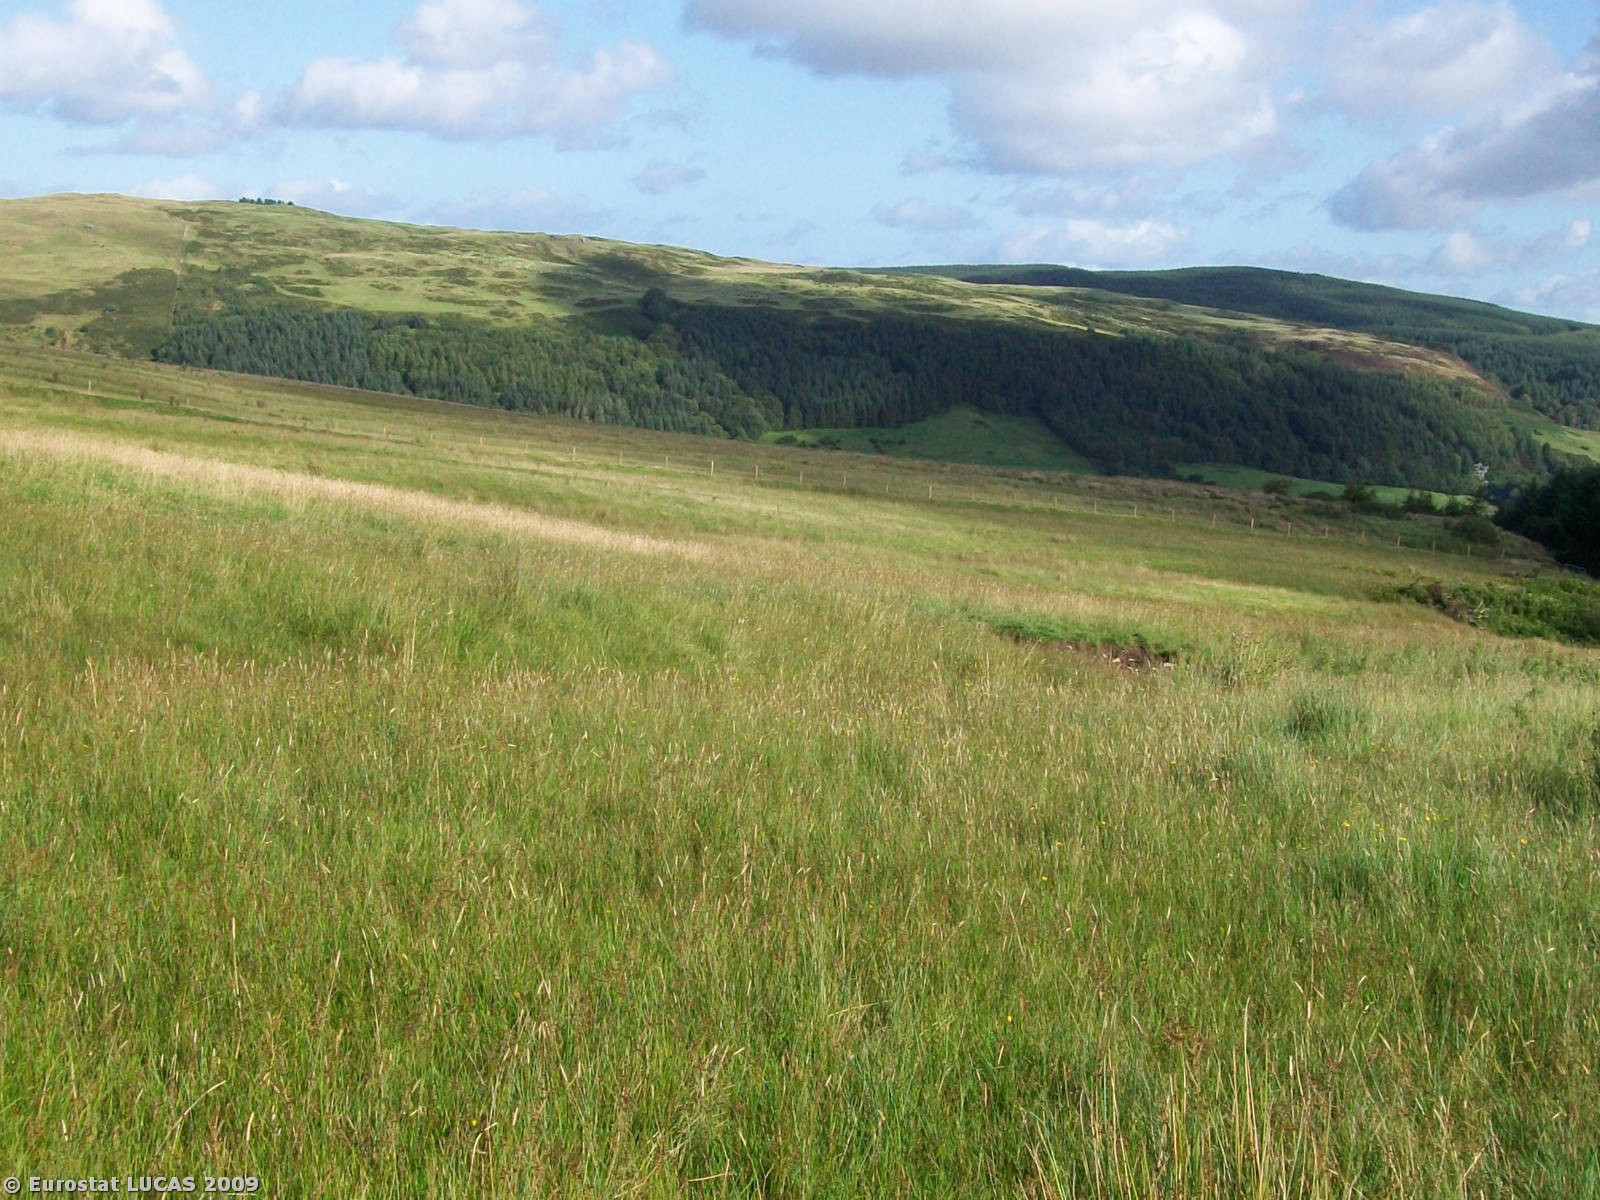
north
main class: Grassland
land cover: Grassland without tree/shrub cover
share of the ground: < 10 %
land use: Agriculture (excluding fallow land and kitchen gardens)
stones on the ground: < 10 %
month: August
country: GB
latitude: 55.1313
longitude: -4.8688
